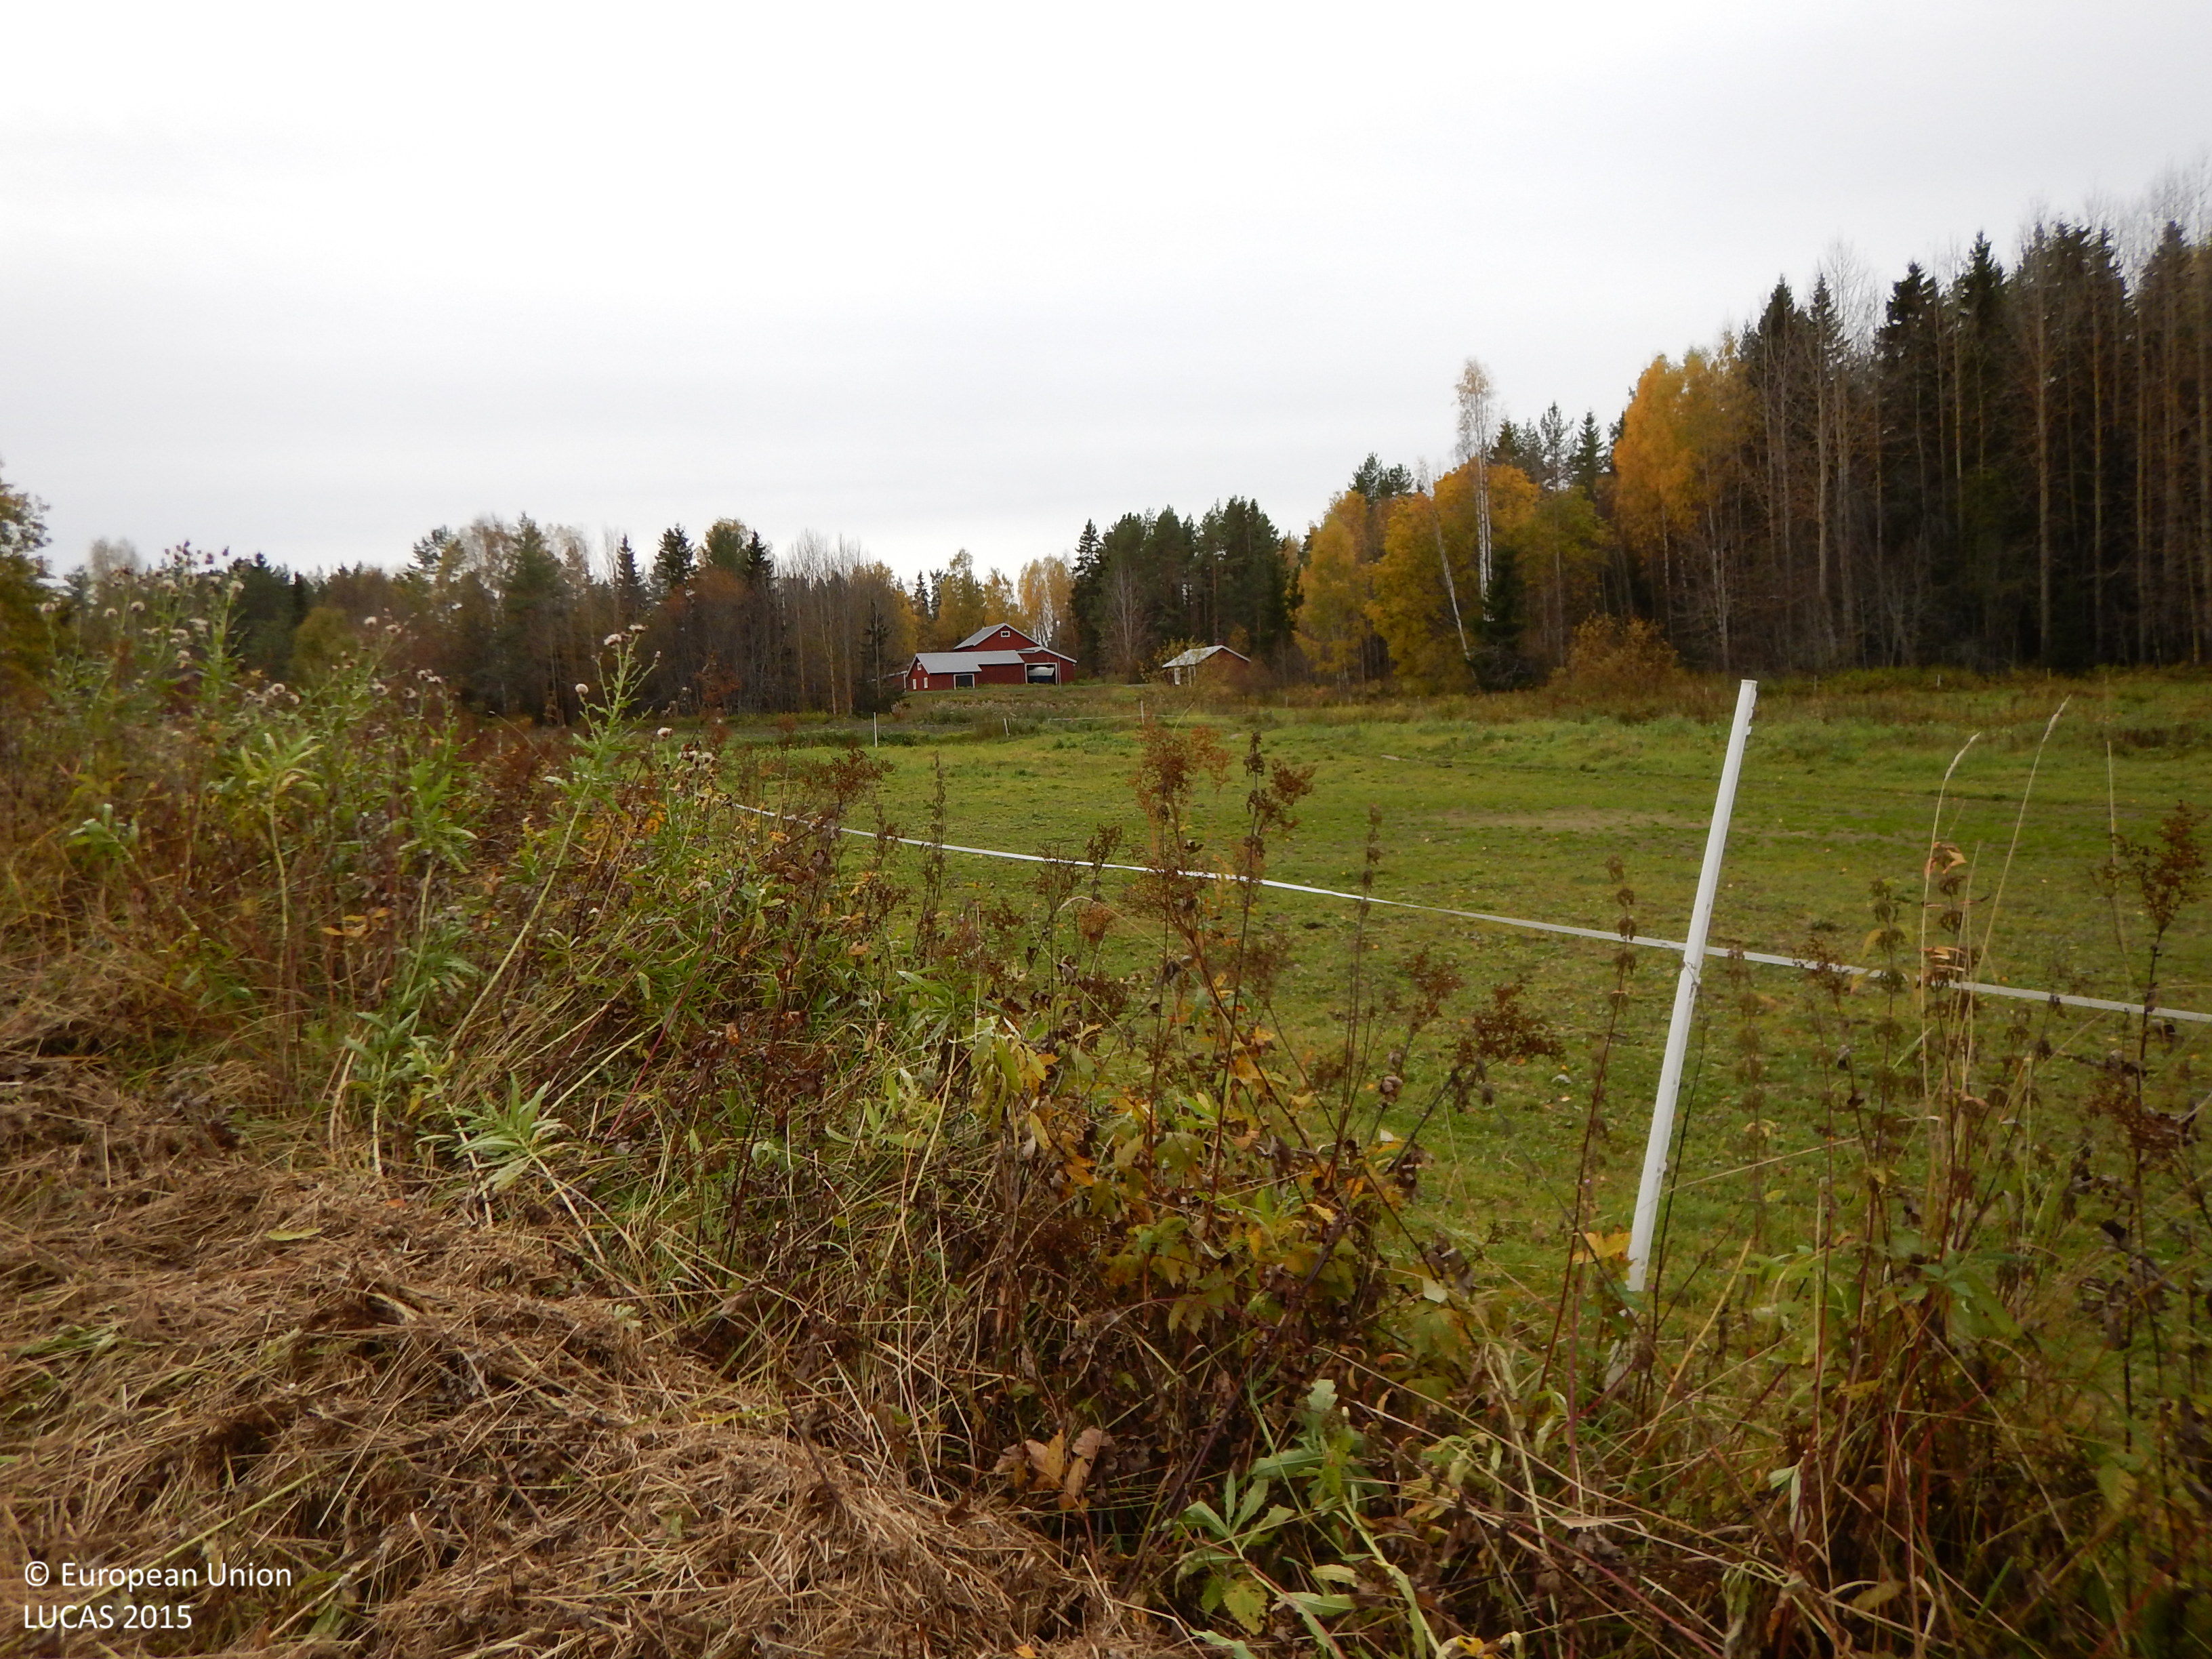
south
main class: Grassland
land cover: Grassland without tree/shrub cover
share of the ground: > 75 %
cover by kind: herbaceous plants 100 %
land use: Agriculture (excluding fallow land and kitchen gardens)
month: October
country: SE
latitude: 64.8455
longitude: 20.8773
